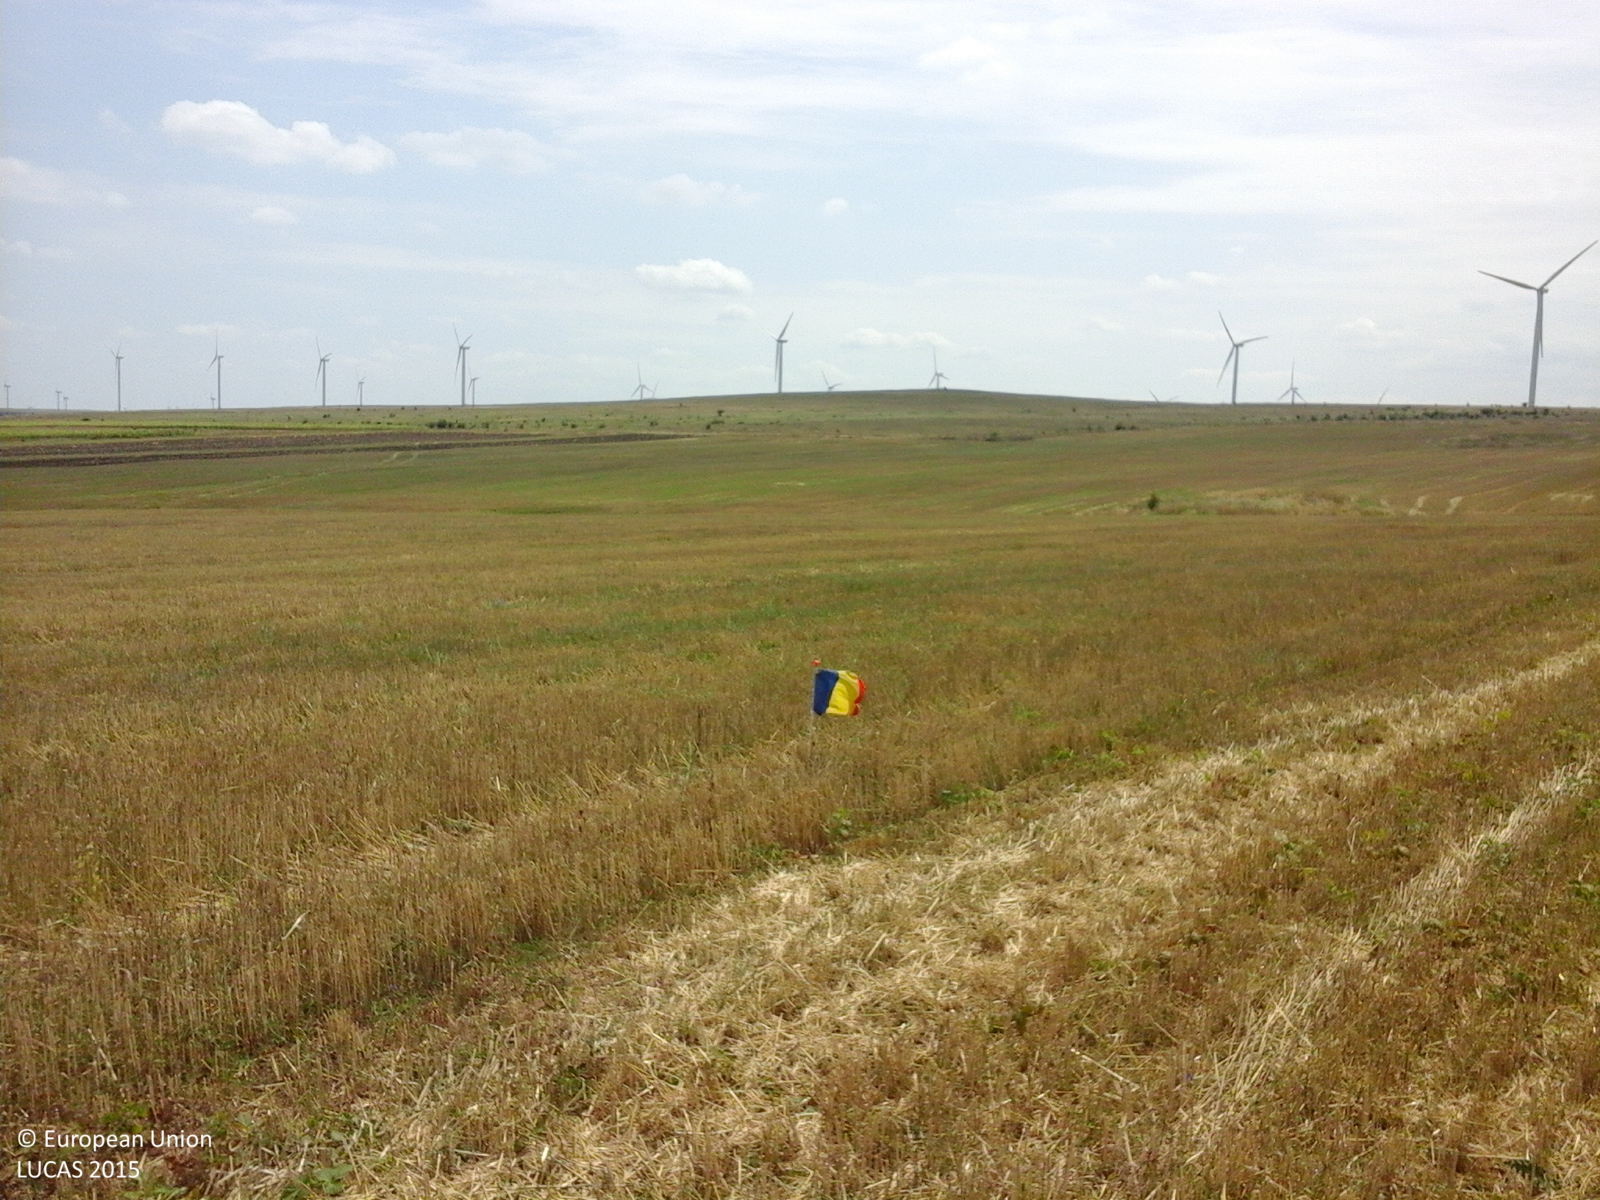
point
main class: Cropland
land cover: Common wheat
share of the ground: > 75 %
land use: Agriculture (excluding fallow land and kitchen gardens)
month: August
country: RO
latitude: 44.6718
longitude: 28.5564
